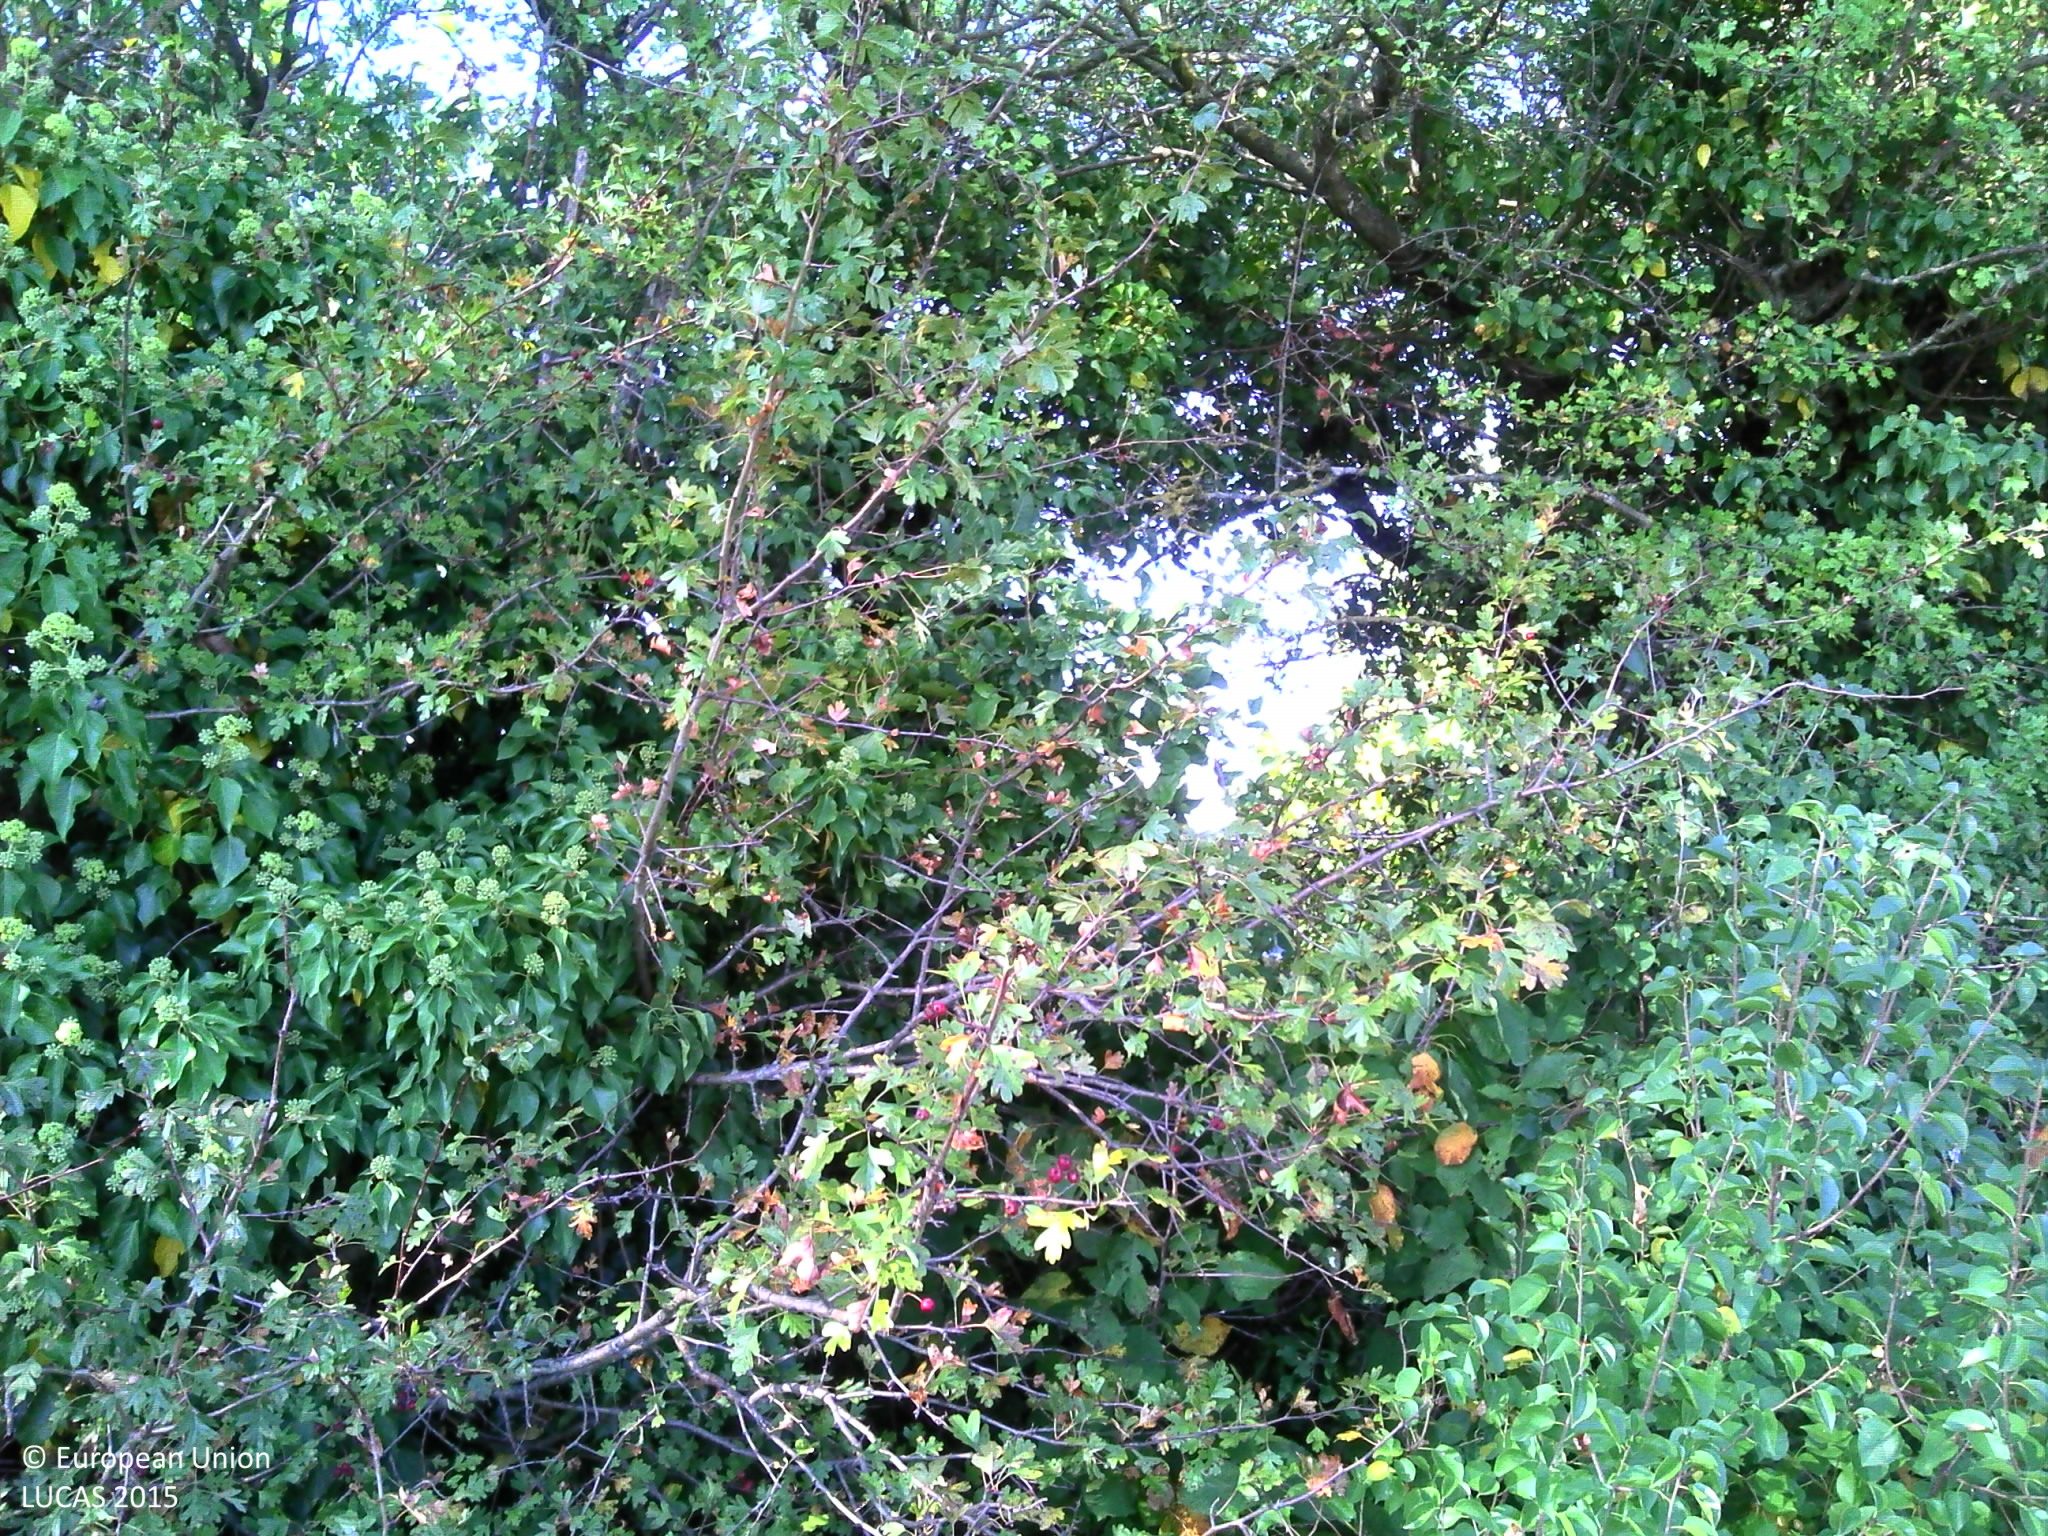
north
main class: Woodland
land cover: Broadleaved woodland
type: mesophytic deciduous forest
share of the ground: > 75 %
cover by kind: broadleaved forest trees 85 %, shrubs 10 %, coniferous forest trees 5 %
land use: Semi-natural and natural areas not in use
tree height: > 5 m
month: September
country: FR
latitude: 45.3134
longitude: 4.9919
